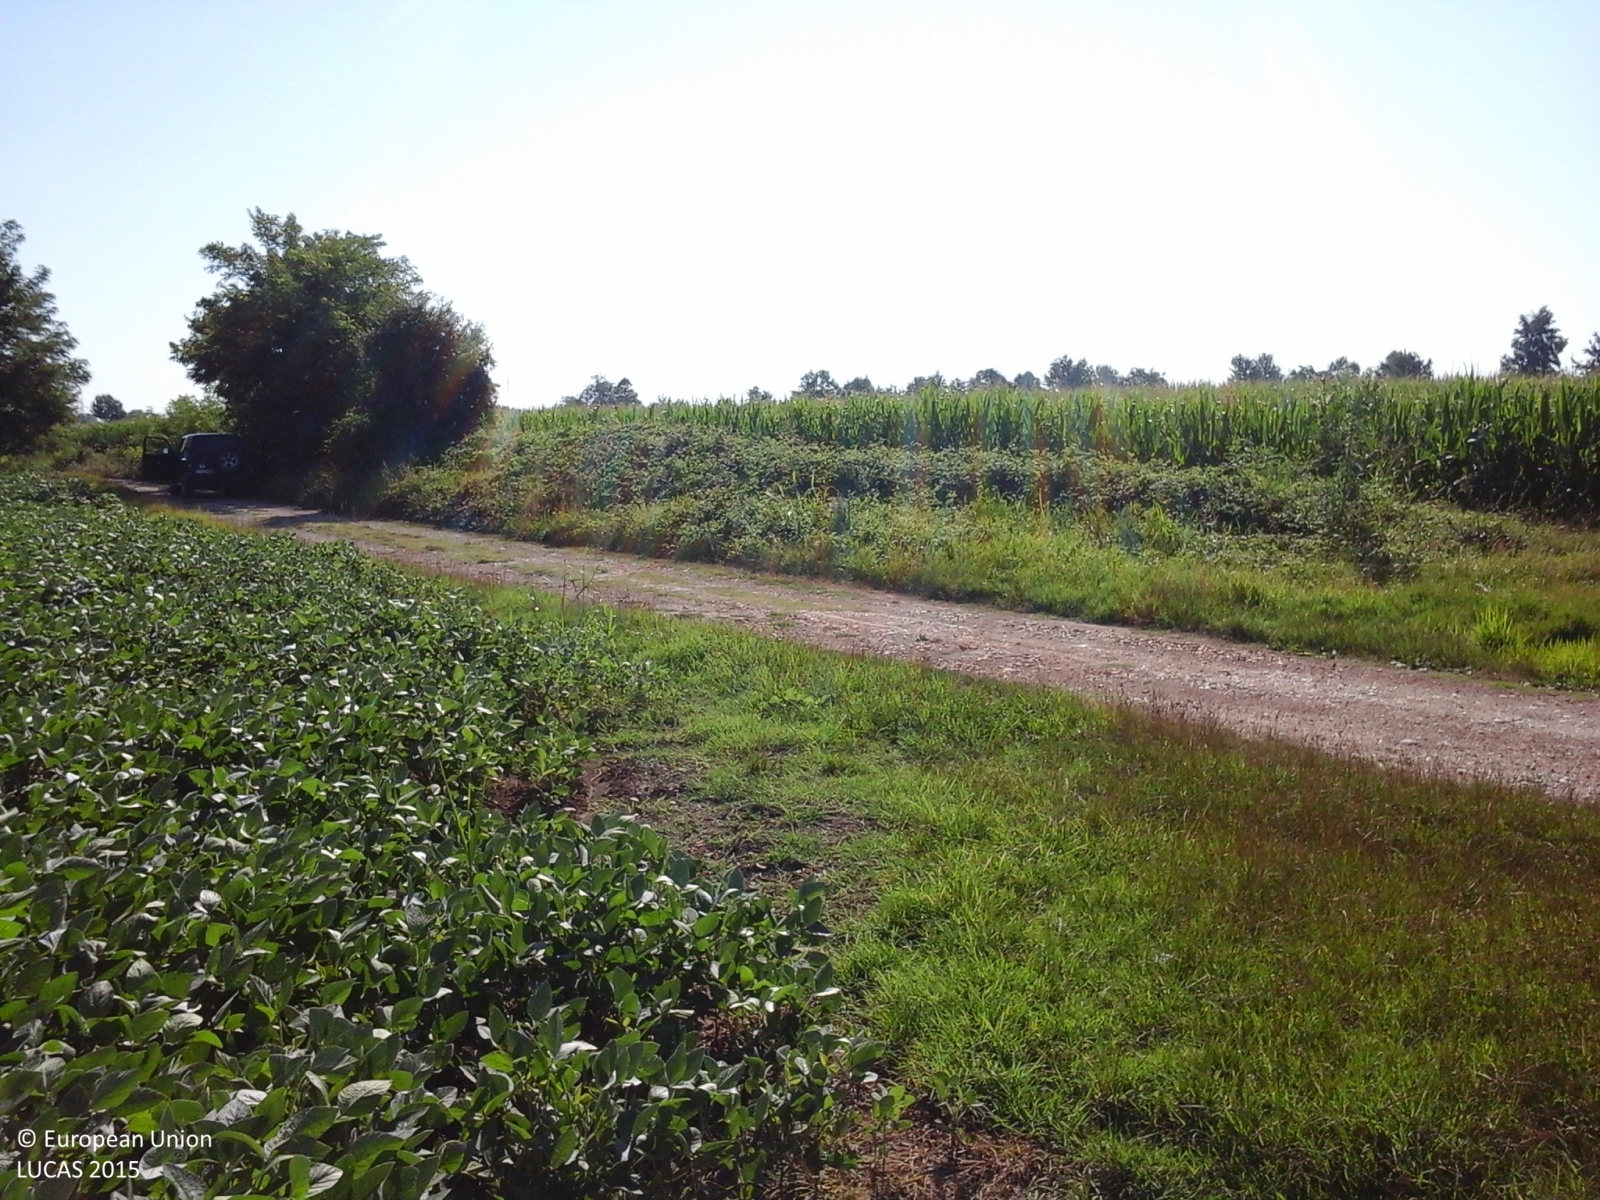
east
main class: Cropland
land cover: Soya
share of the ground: > 75 %
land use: Agriculture (excluding fallow land and kitchen gardens)
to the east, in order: Soya; Grassland without tree/shrub cover; Lines of trees; Ditches and canals; Lines of trees; Grassland without tree/shrub cover; Soya; Grass margins; Tracks; Managed hedges; Ditches and canals; Maize
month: July
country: IT
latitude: 45.7307
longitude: 12.3482
